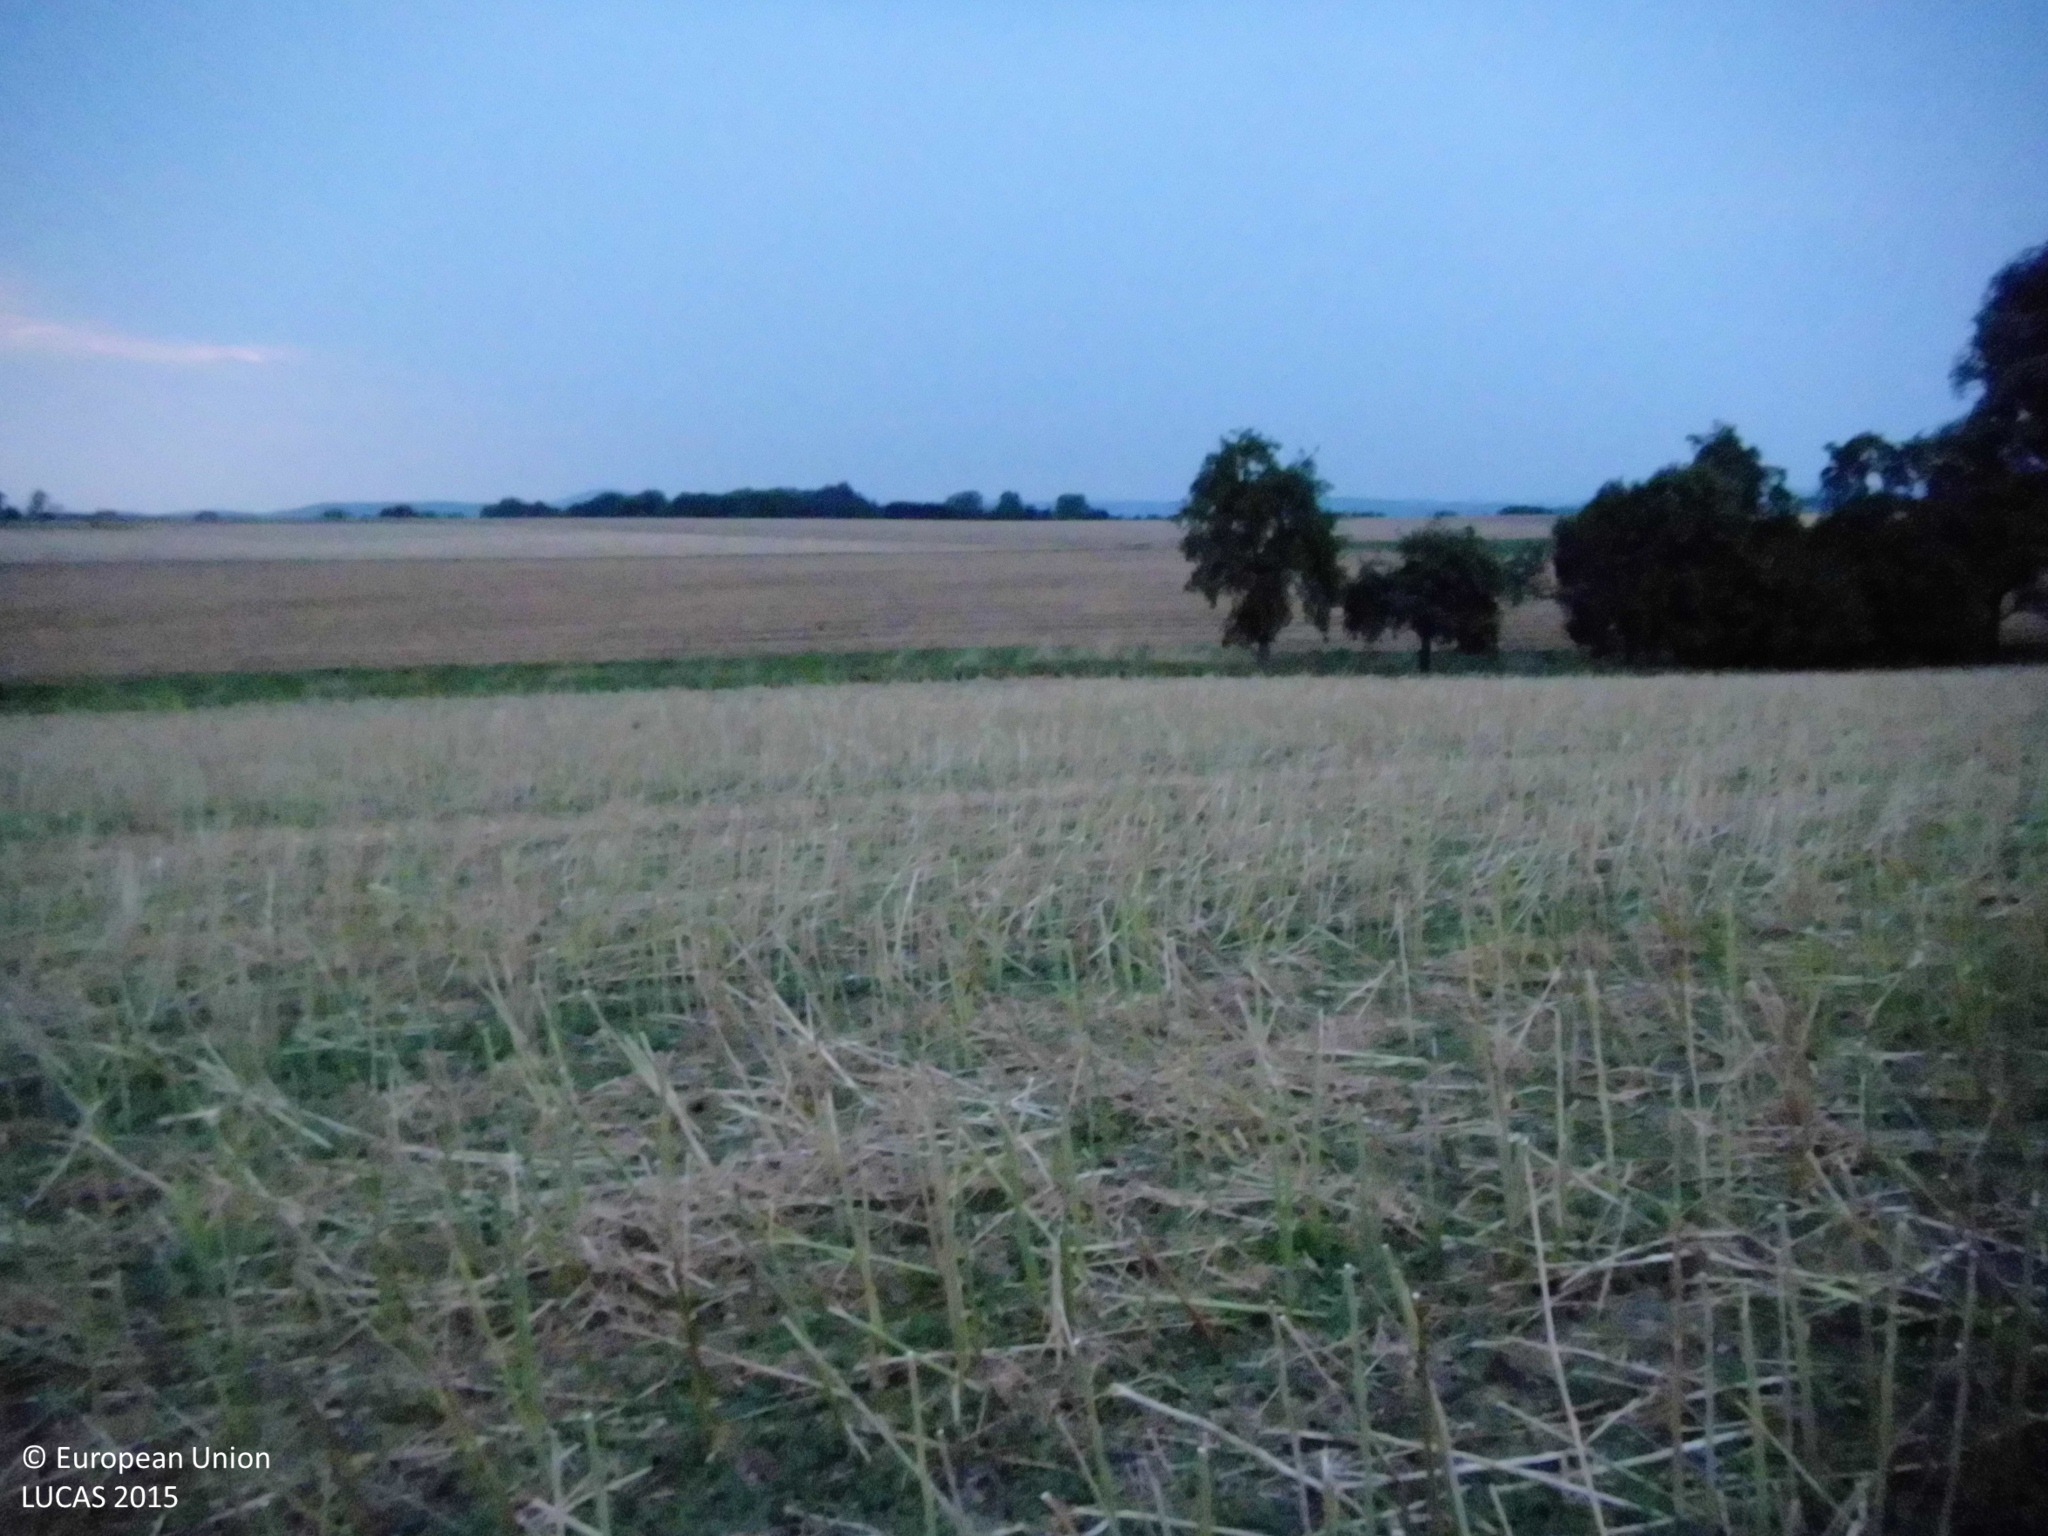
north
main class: Cropland
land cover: Rape and turnip rape
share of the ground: > 75 %
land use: Agriculture (excluding fallow land and kitchen gardens)
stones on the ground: < 10 %
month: August
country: DE
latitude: 50.5354
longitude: 8.6036
